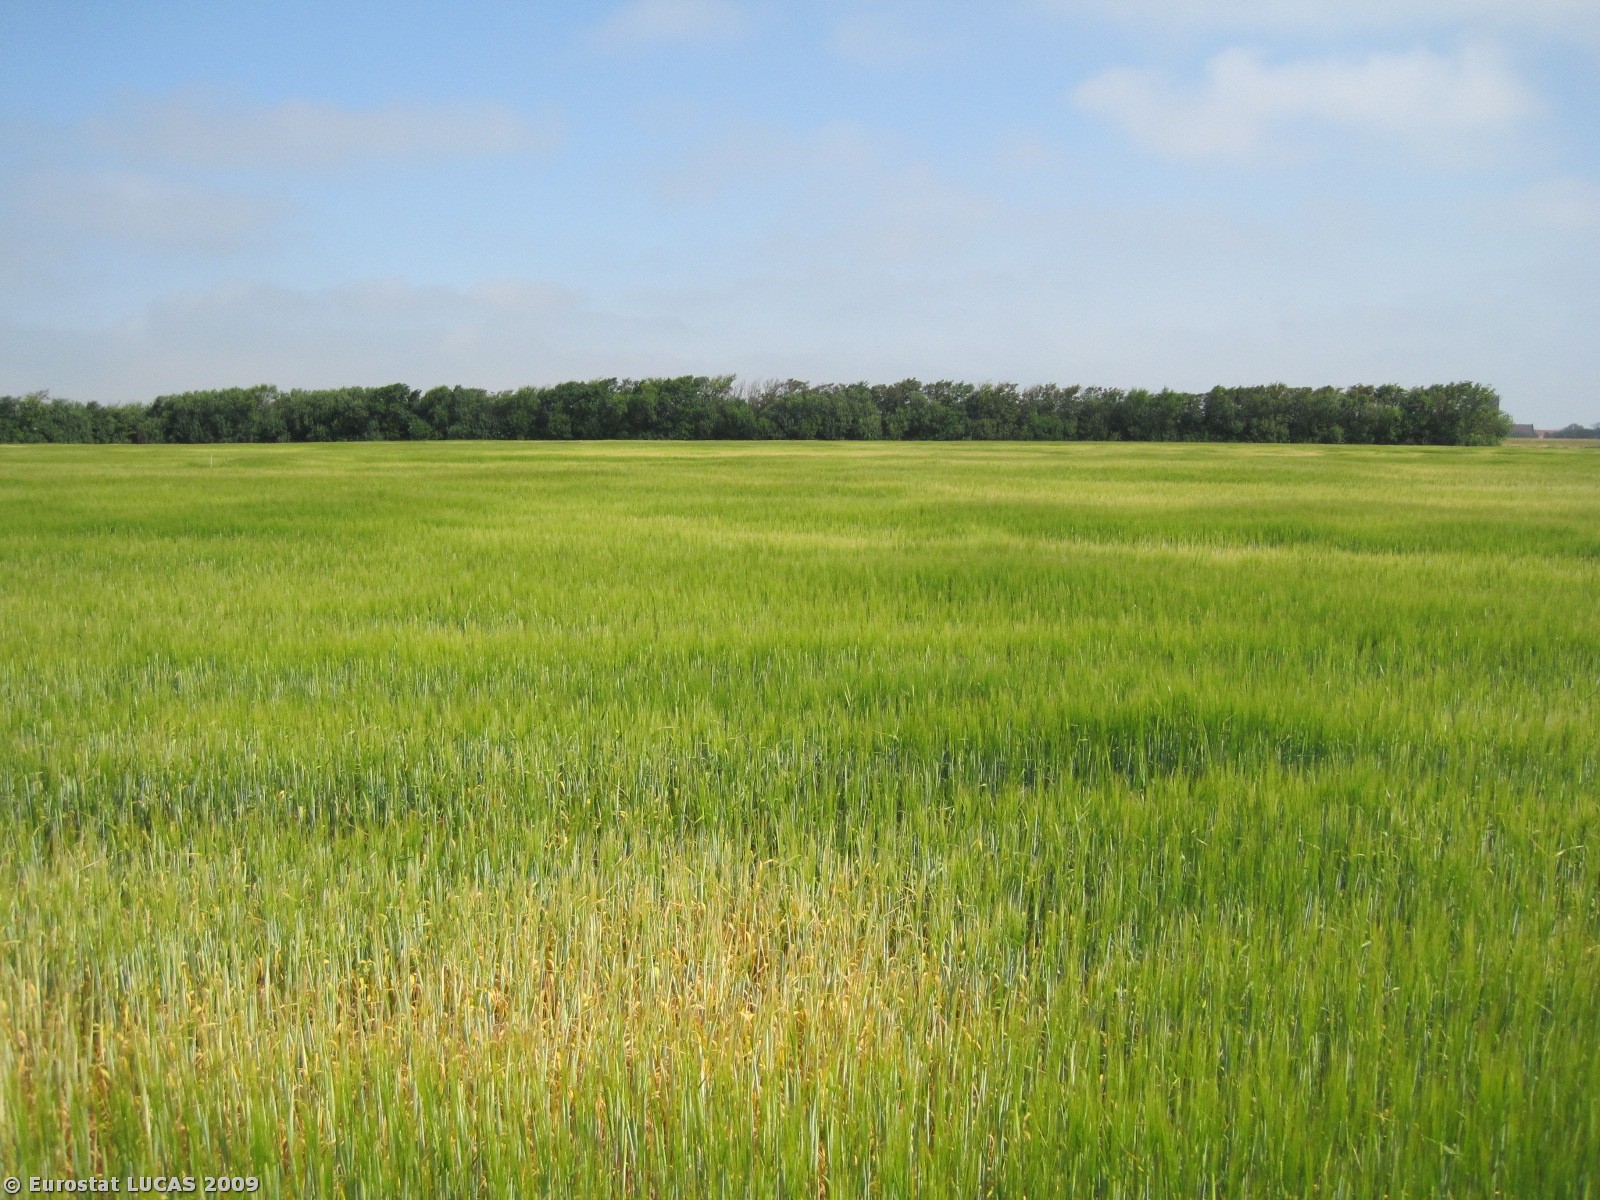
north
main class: Cropland
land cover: Barley
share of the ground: > 75 %
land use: Agriculture (excluding fallow land and kitchen gardens)
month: July
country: DK
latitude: 56.4444
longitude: 8.1691
